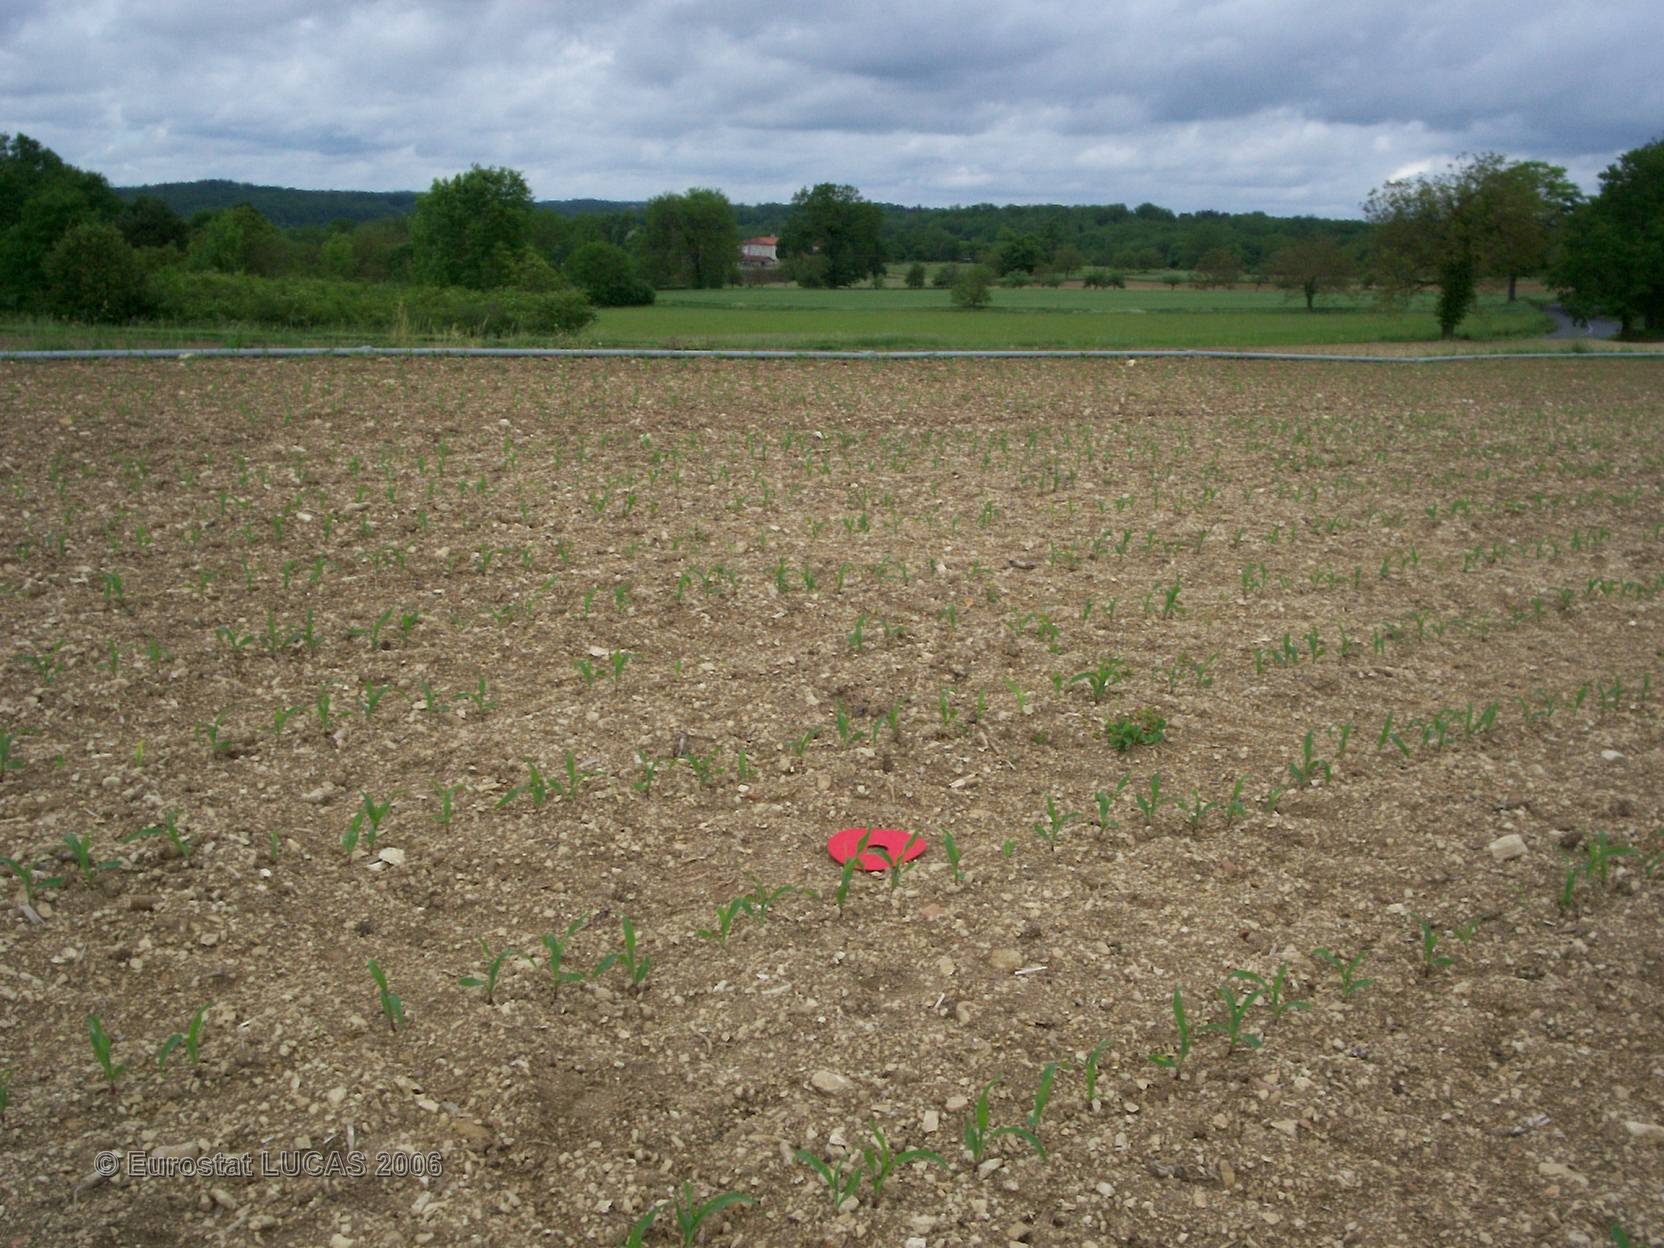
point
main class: Cropland
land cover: Maize
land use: Agriculture (excluding fallow land and kitchen gardens)
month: May
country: FR
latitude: 45.2986
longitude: 0.5645
